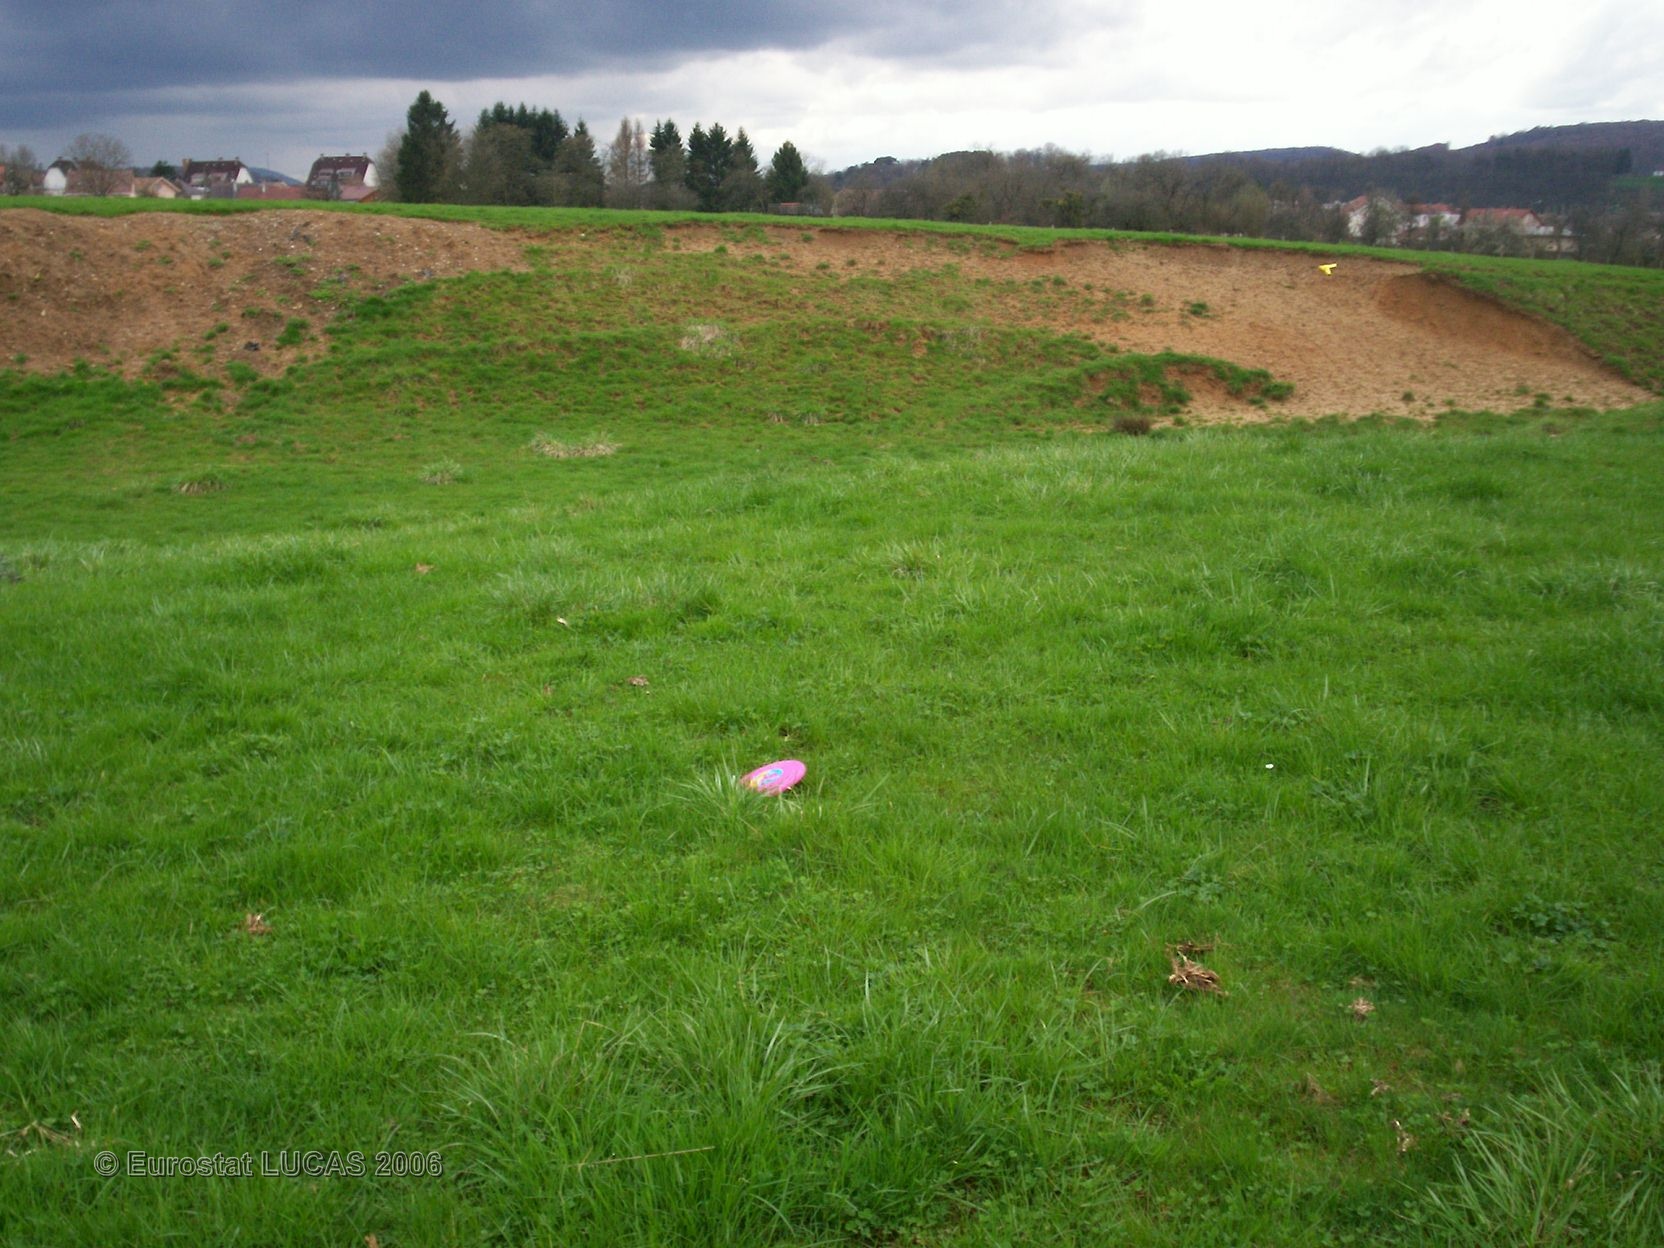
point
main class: Grassland
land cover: Grassland without tree/shrub cover
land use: Agriculture (excluding fallow land and kitchen gardens)
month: April
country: FR
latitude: 47.4504
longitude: 6.5932
